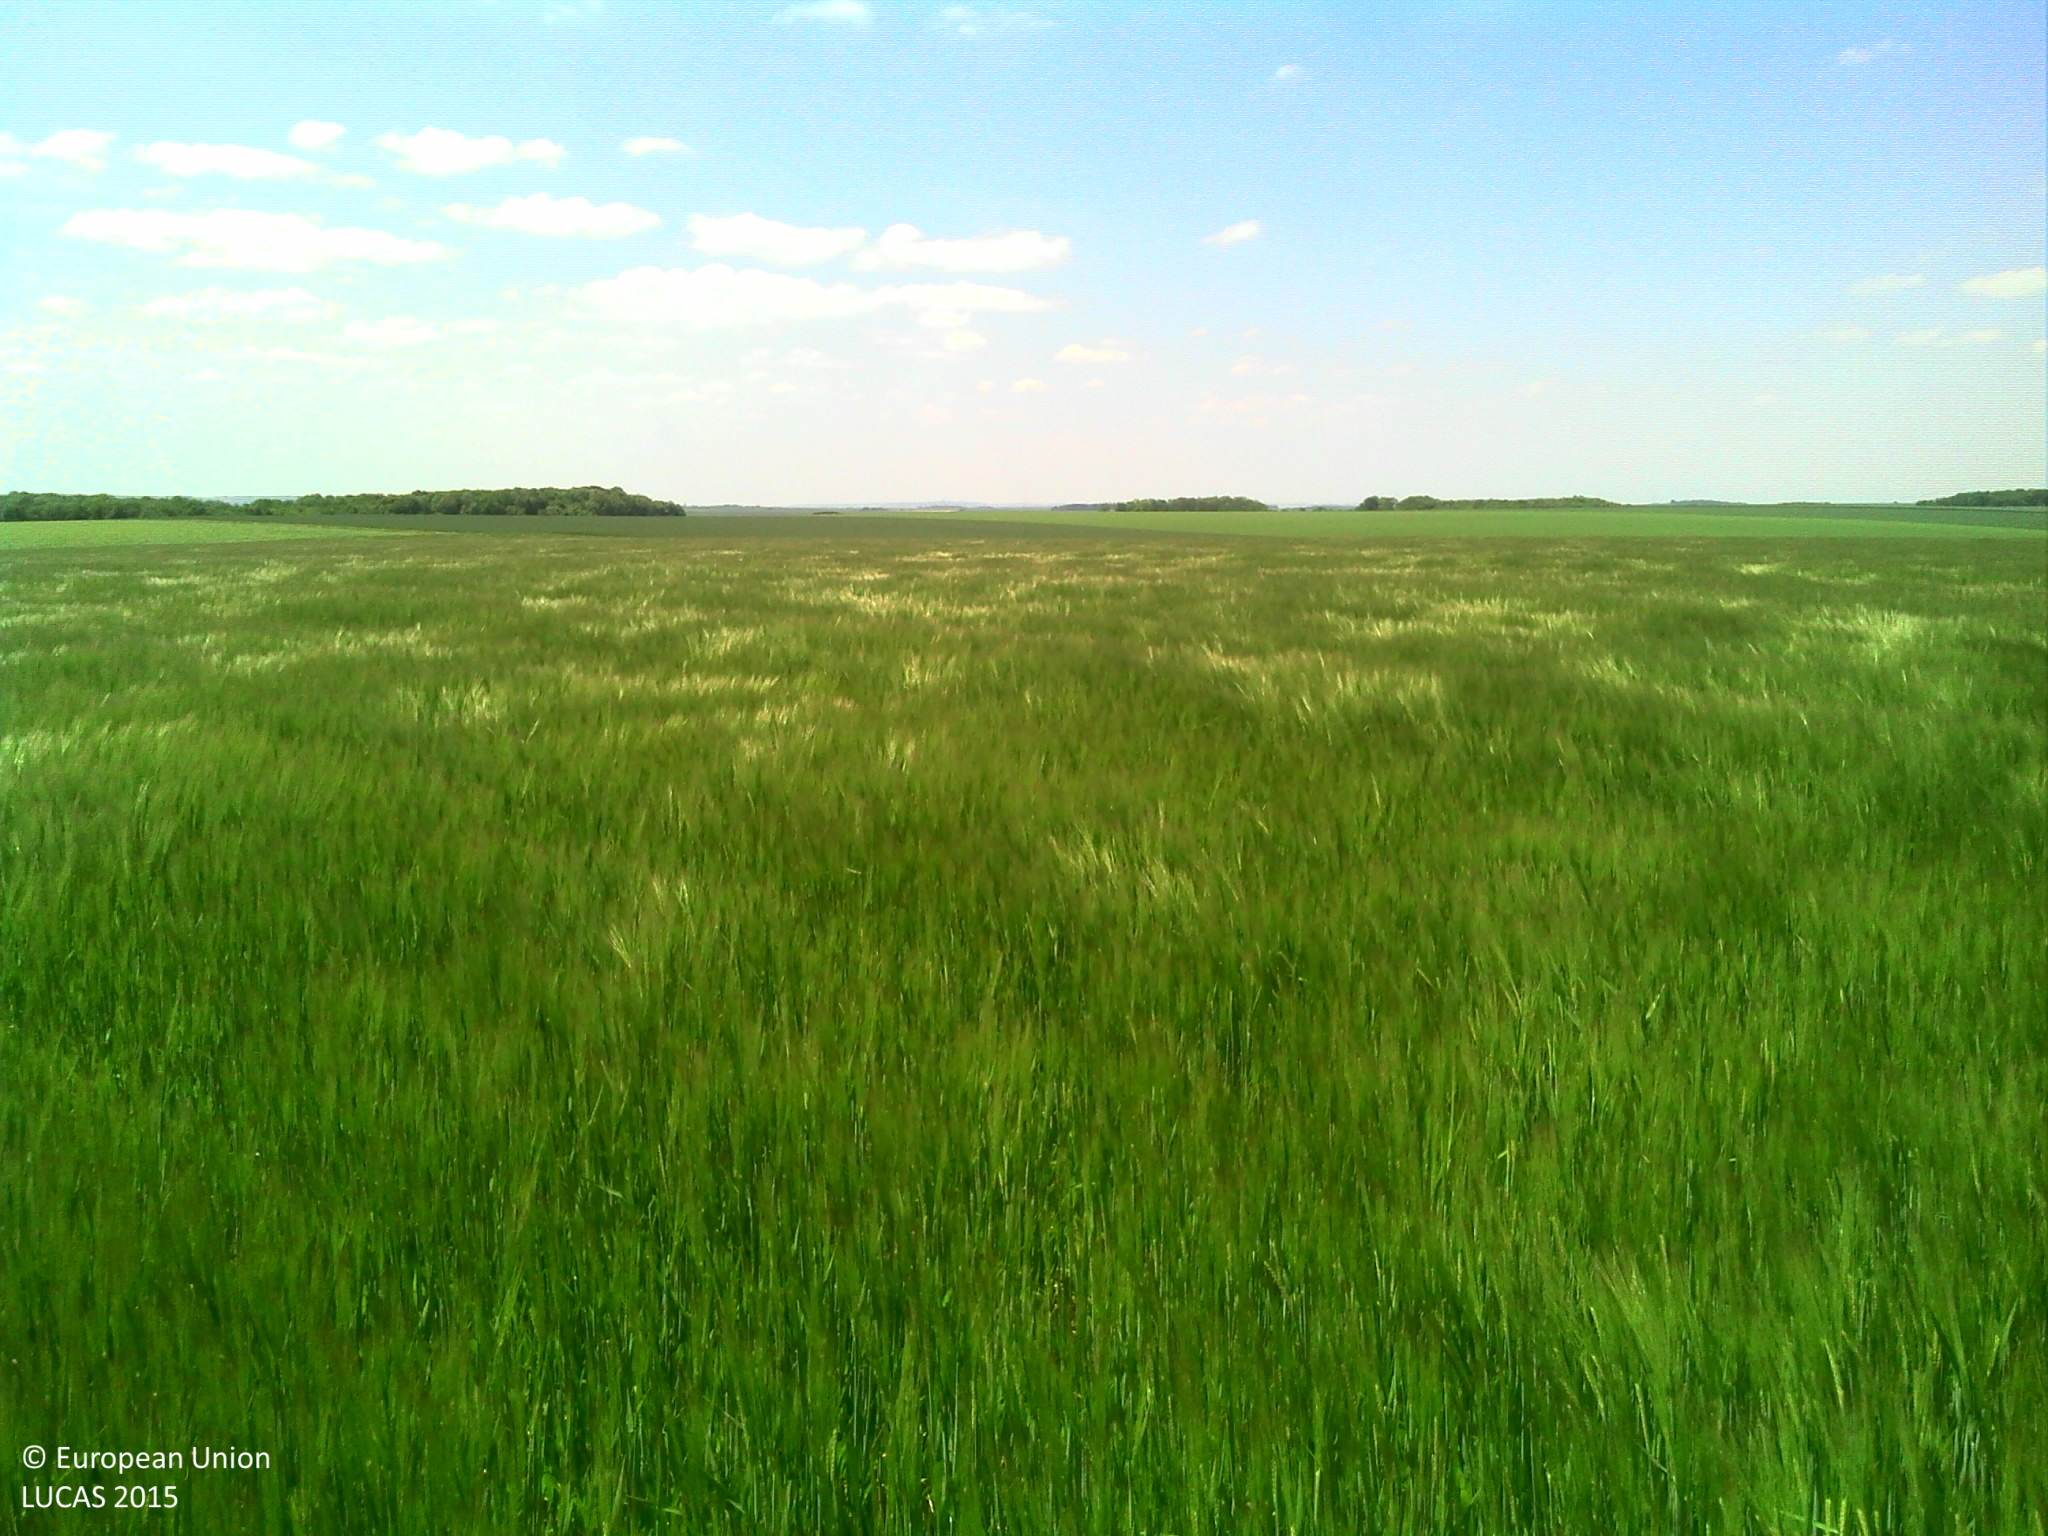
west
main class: Cropland
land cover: Rye
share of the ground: > 75 %
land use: Agriculture (excluding fallow land and kitchen gardens)
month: June
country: FR
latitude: 49.6504
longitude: 4.0529
